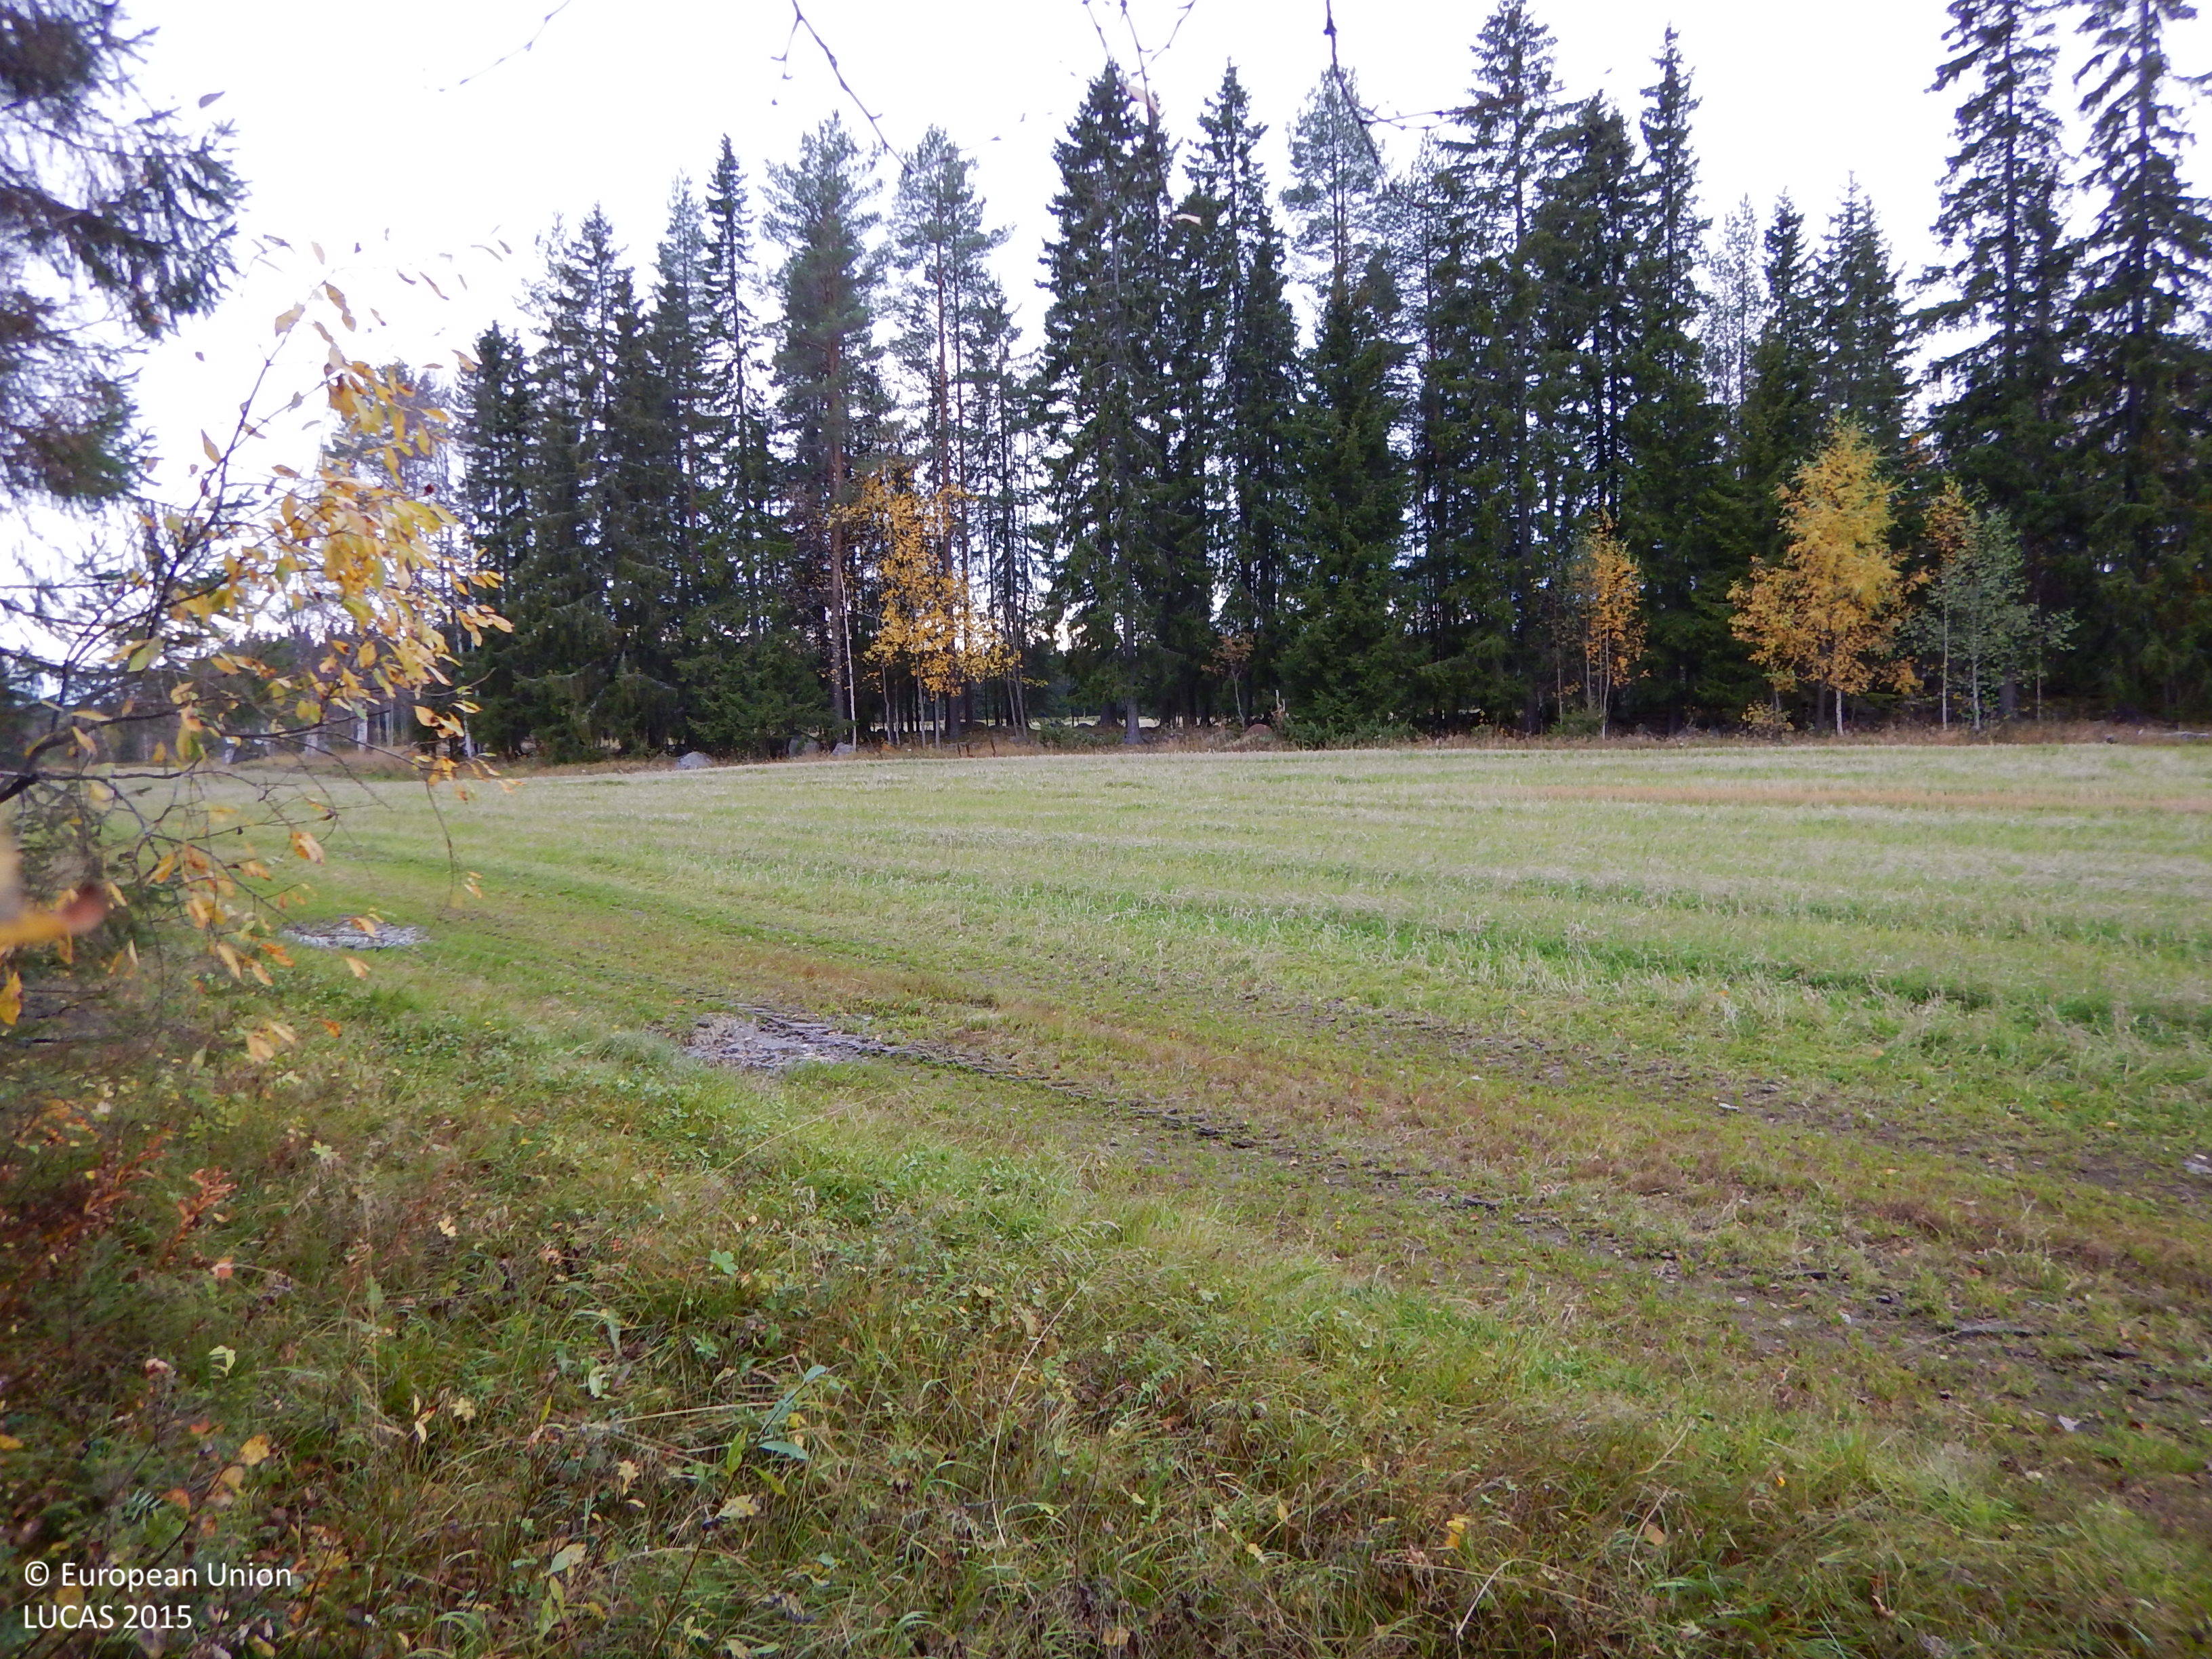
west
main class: Woodland
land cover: Spruce dominated mixed woodland
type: boreal forest
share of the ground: > 75 %
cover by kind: coniferous forest trees 60 %, broadleaved forest trees 20 %, shrubs 10 %, herbaceous plants 5 %, lichens and mosses 5 %
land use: Forestry
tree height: > 5 m
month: October
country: SE
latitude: 64.8811
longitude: 20.8915
